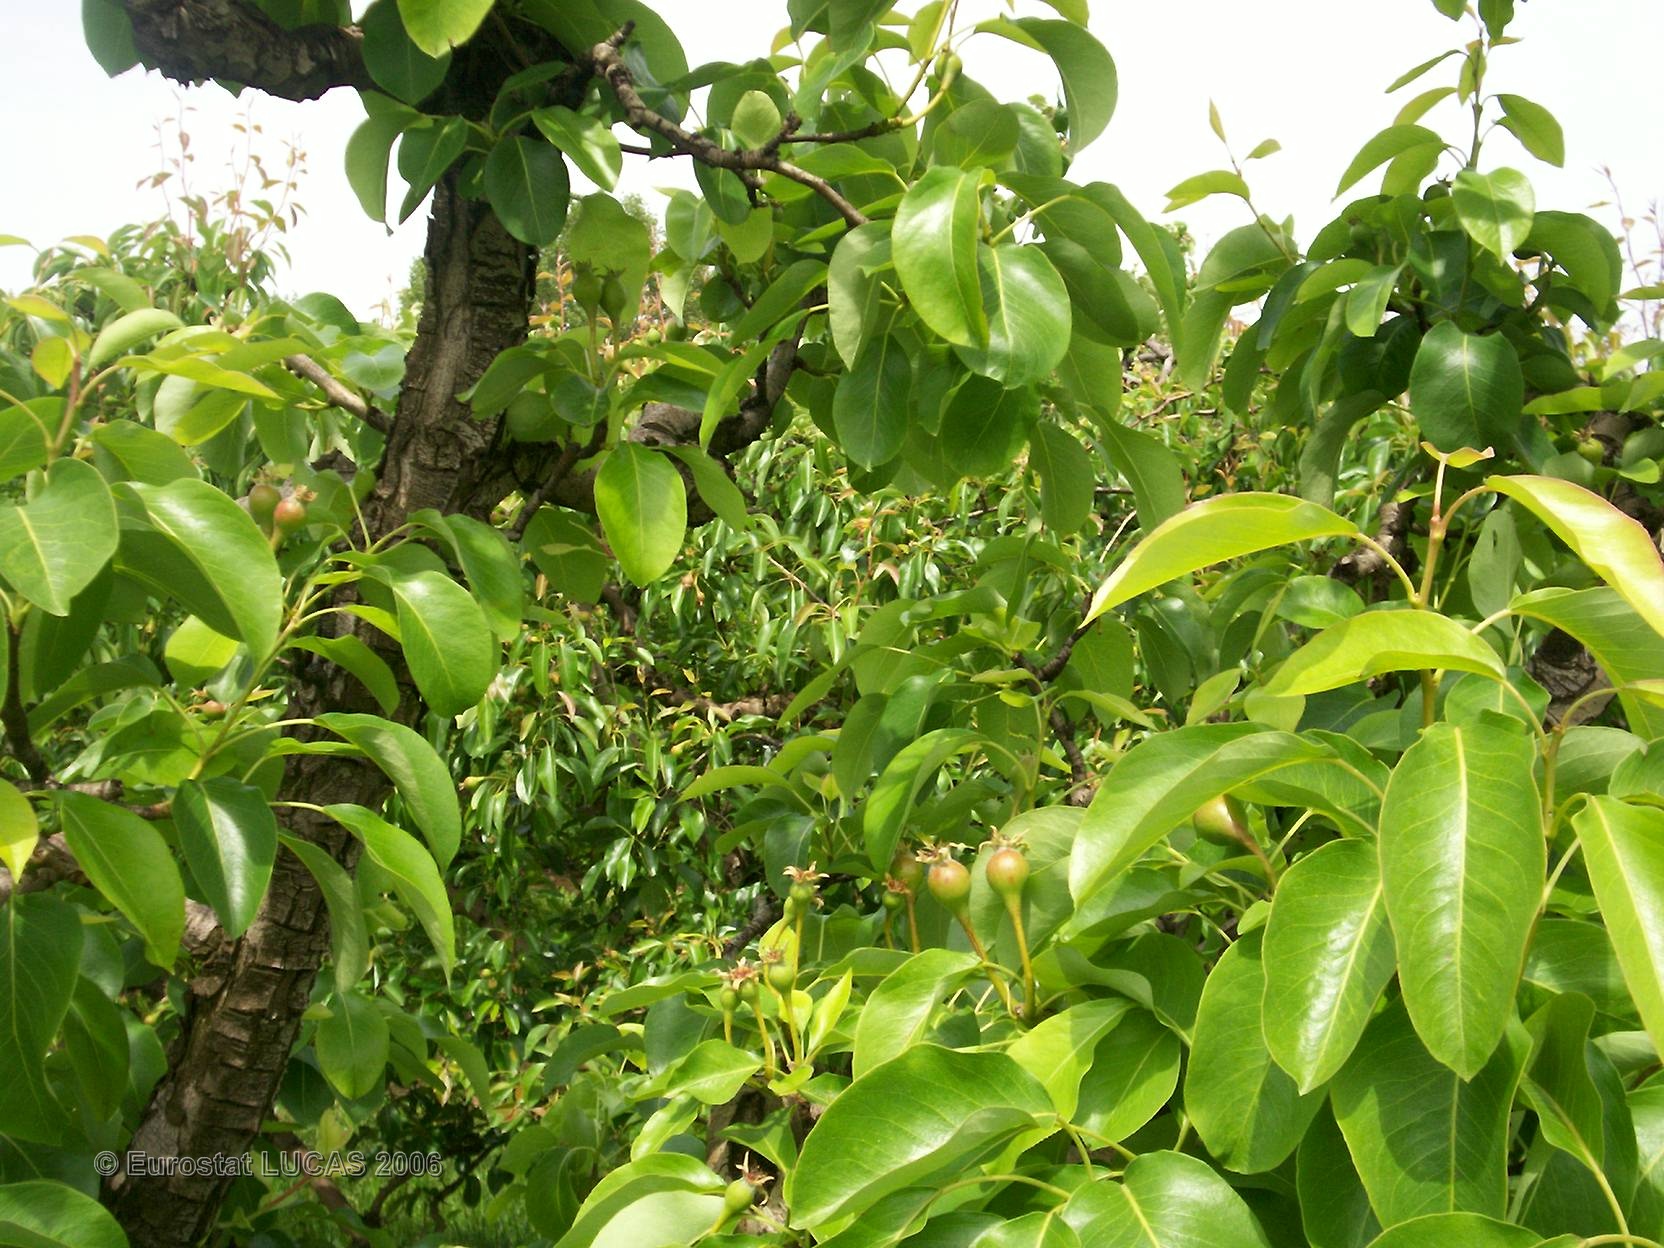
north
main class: Cropland
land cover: Pear fruit
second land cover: Grassland with sparse tree/shrub cover
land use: Agriculture (excluding fallow land and kitchen gardens)
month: May
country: FR
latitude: 45.6654
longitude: 4.8055
